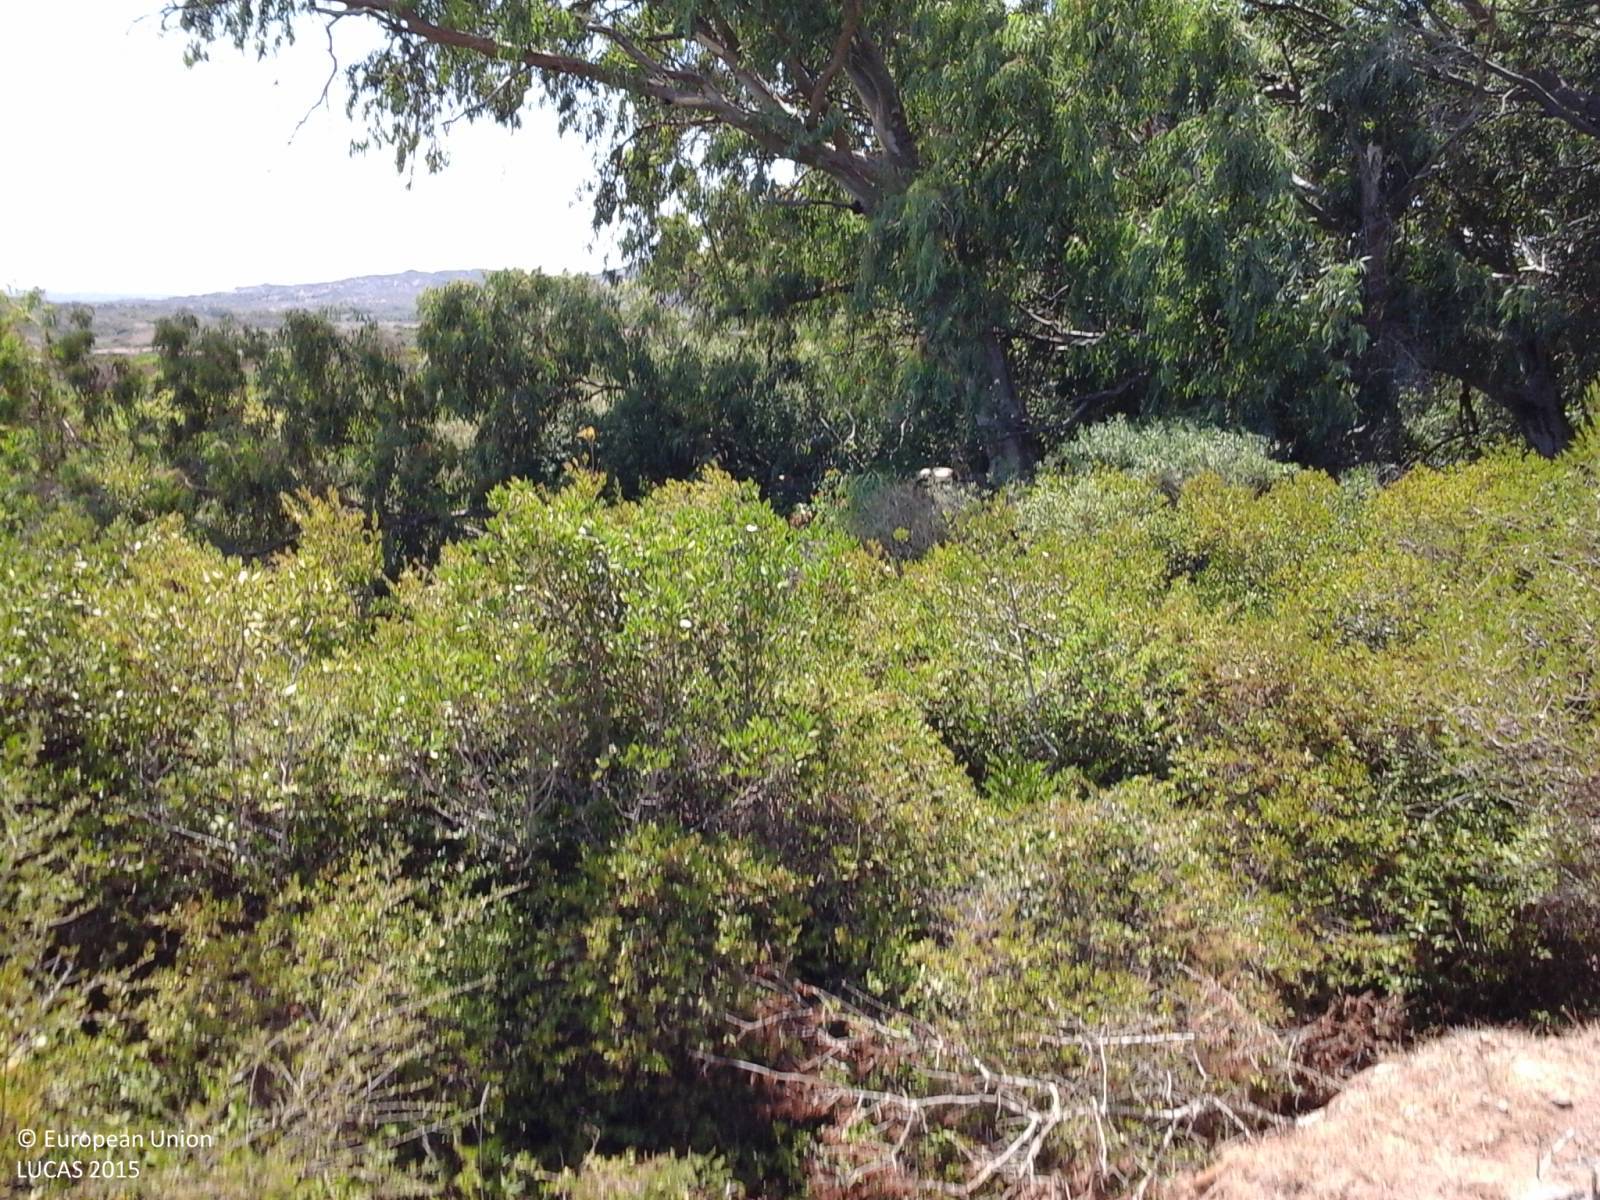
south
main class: Shrubland
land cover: Shrubland with sparse tree cover
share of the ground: > 75 %
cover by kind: shrubs 60 %, herbaceous plants 35 %, broadleaved forest trees 5 %
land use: Semi-natural and natural areas not in use
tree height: > 5 m
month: July
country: IT
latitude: 41.2414
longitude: 9.2278
